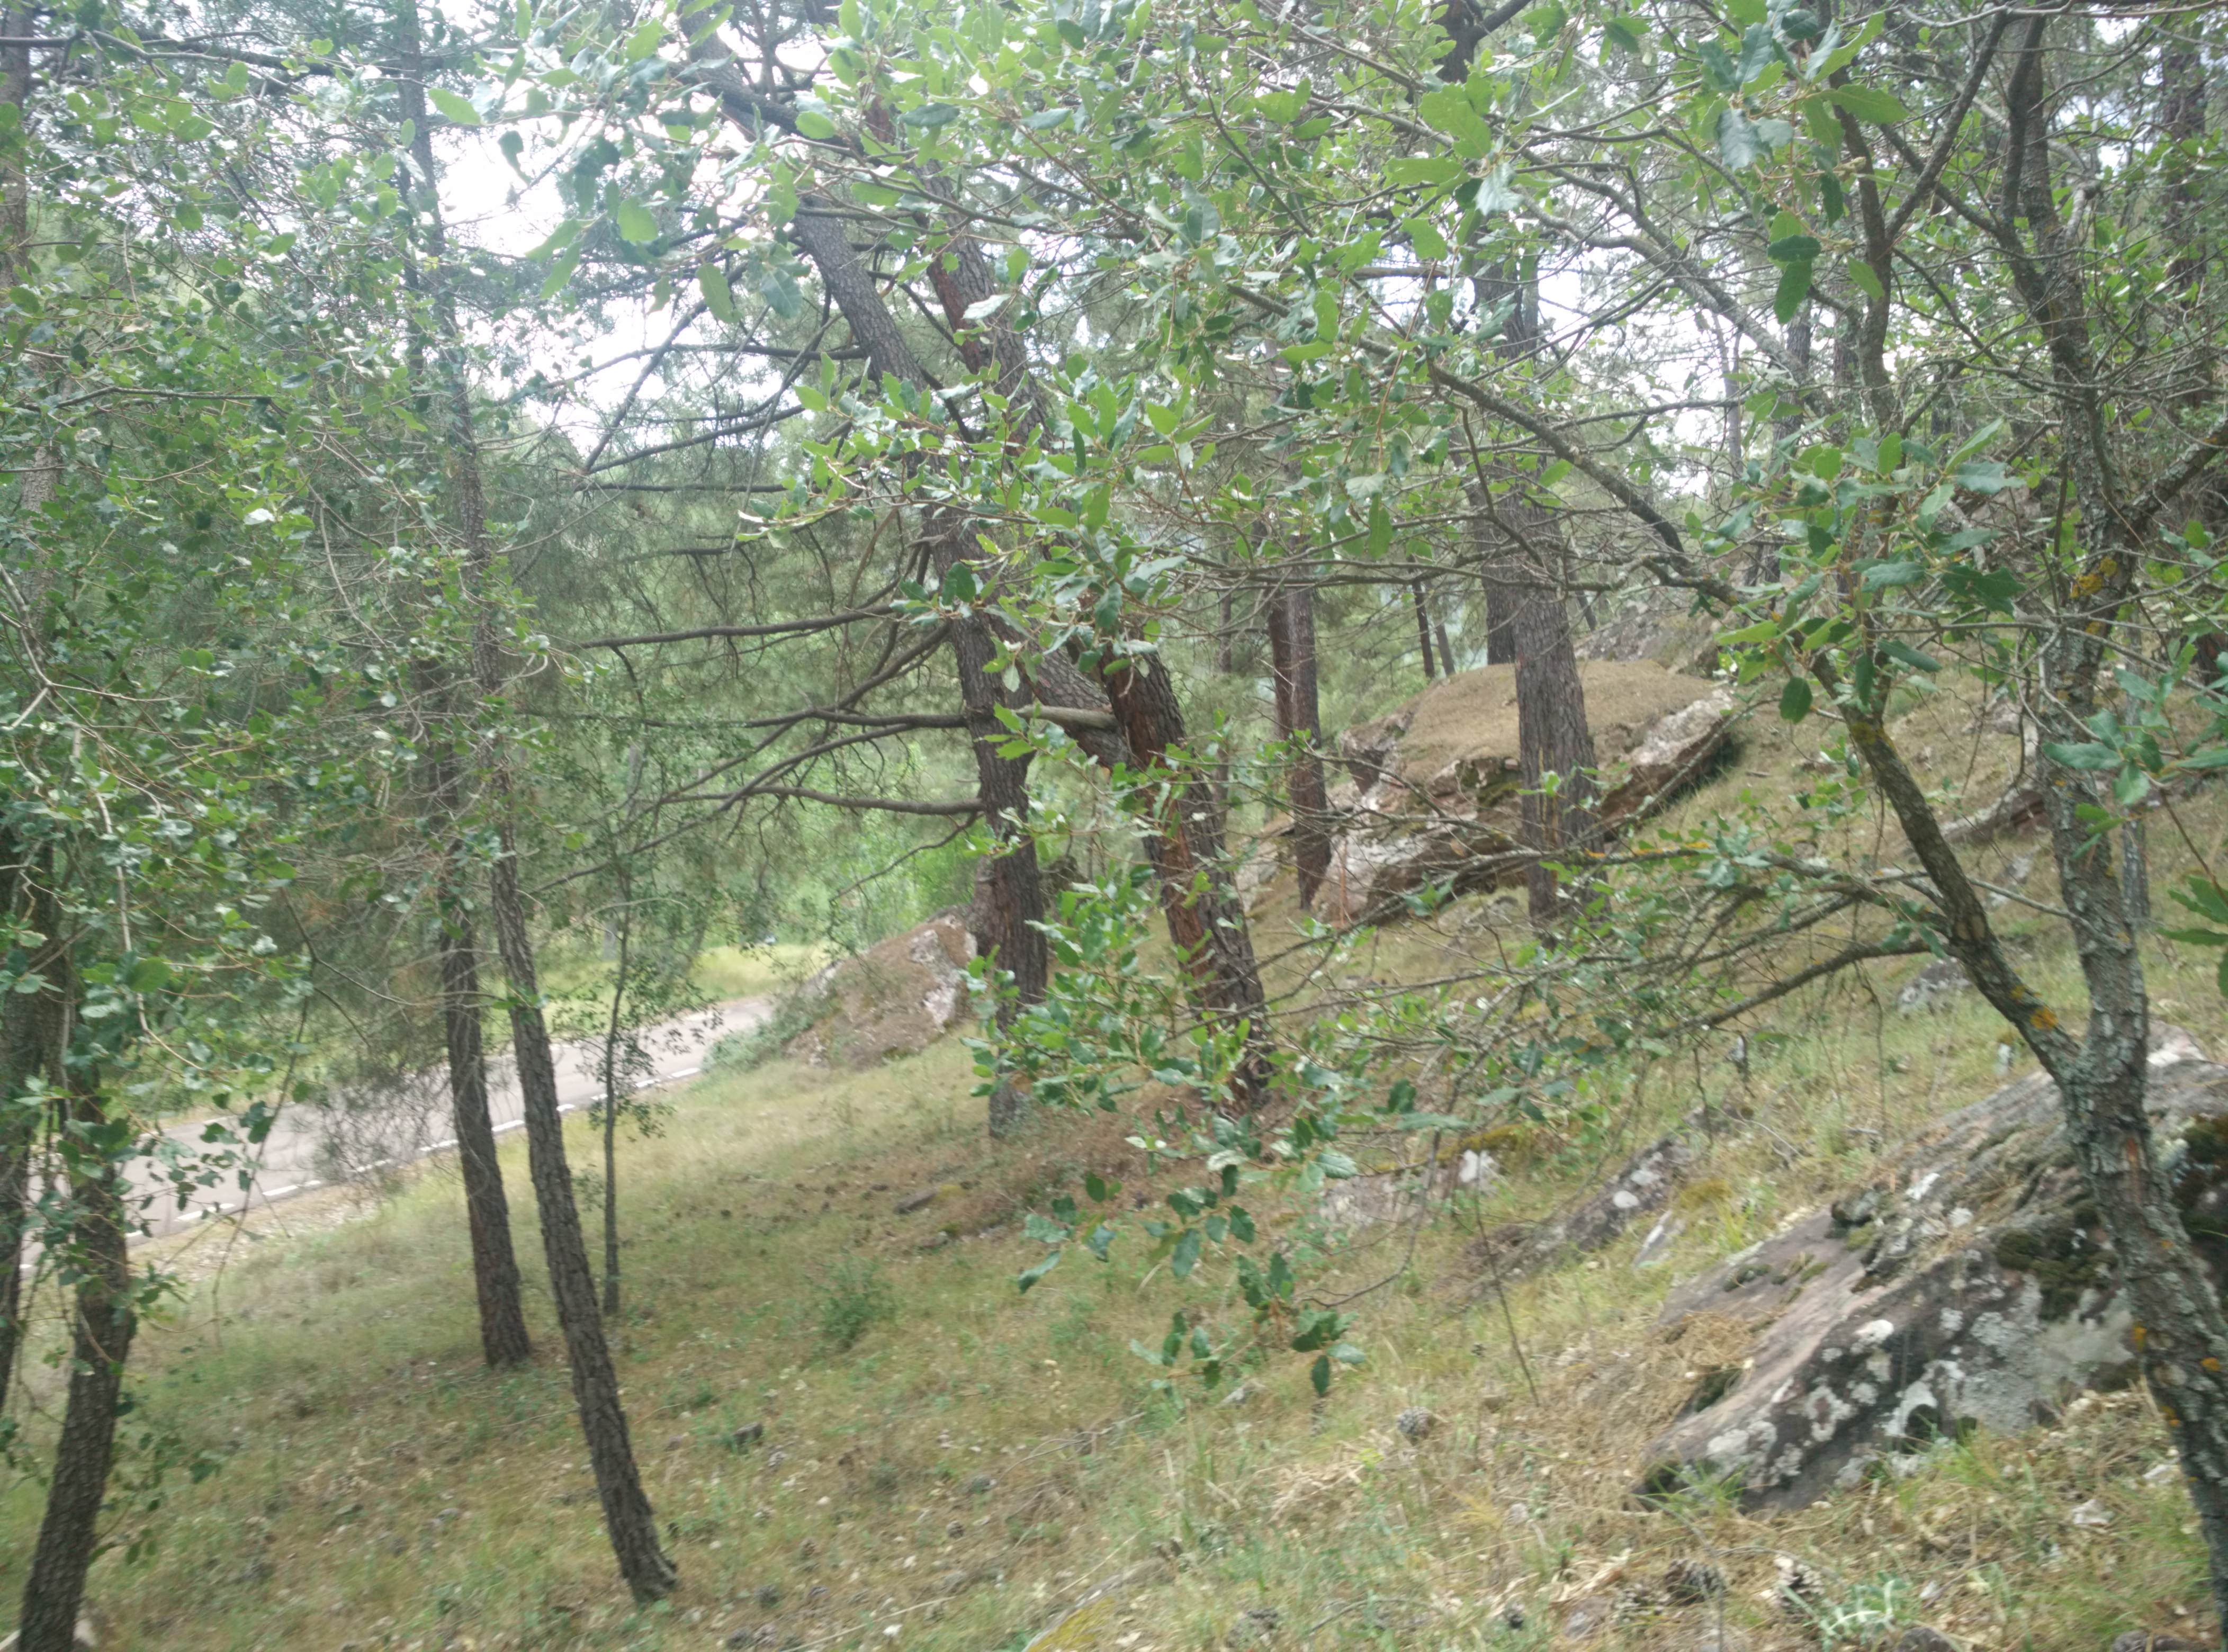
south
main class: Woodland
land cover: Pine dominated coniferous woodland
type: coniferous forest of the mediterranean region
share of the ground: 50 - 75 %
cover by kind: coniferous forest trees 60 %, unconsolidated bare surface 30 %, shrubs 10 %
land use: Semi-natural and natural areas not in use
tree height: > 5 m
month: July
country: ES
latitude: 40.8235
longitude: -2.0105
